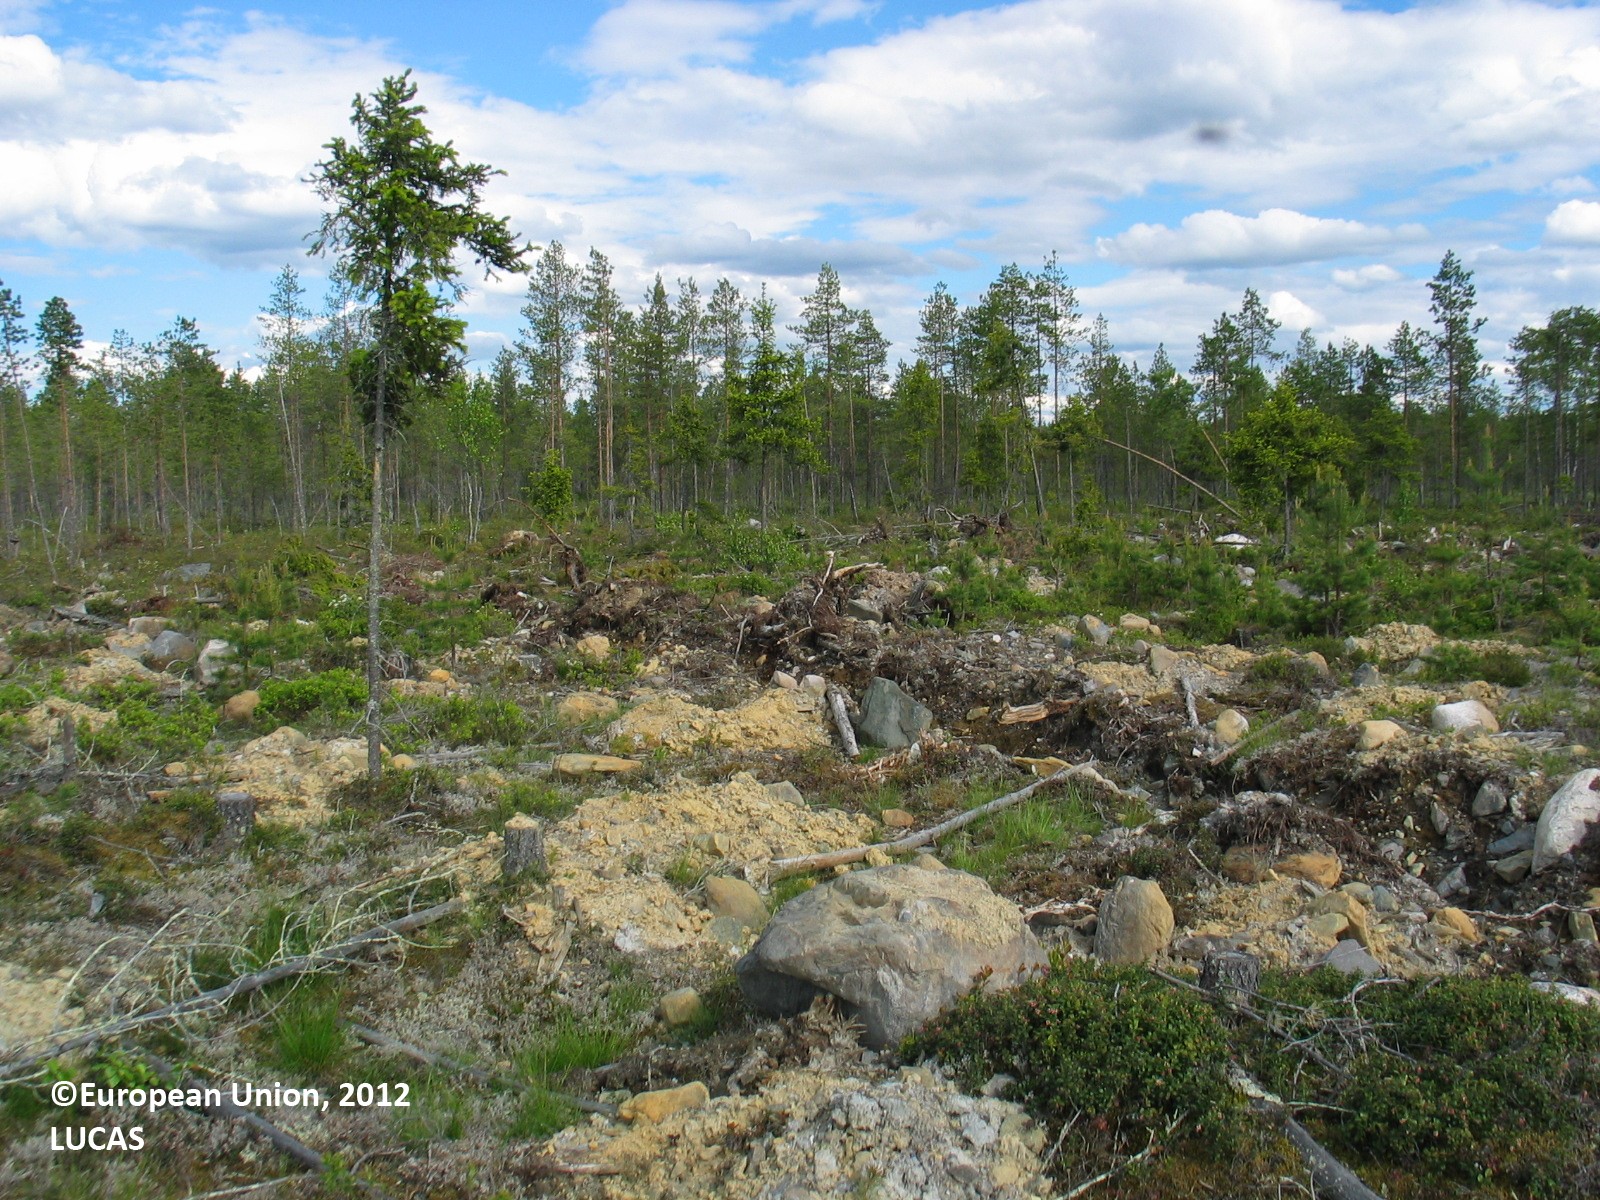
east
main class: Shrubland
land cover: Shrubland without tree cover
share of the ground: 25 - 50 %
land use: Forestry
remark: Clear cut
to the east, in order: Shrubland without tree cover; Ditches and canals; Shrubland without tree cover; Pine dominated coniferous woodland; Ditches and canals; Pine dominated coniferous woodland; Ditches and canals; Pine dominated coniferous woodland; Ditches and canals; Pine dominated coniferous woodland; Peatbogs; Pine dominated coniferous woodland; Ditches and canals; Pine dominated coniferous woodland
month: June
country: FI
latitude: 64.8955
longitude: 26.5236
